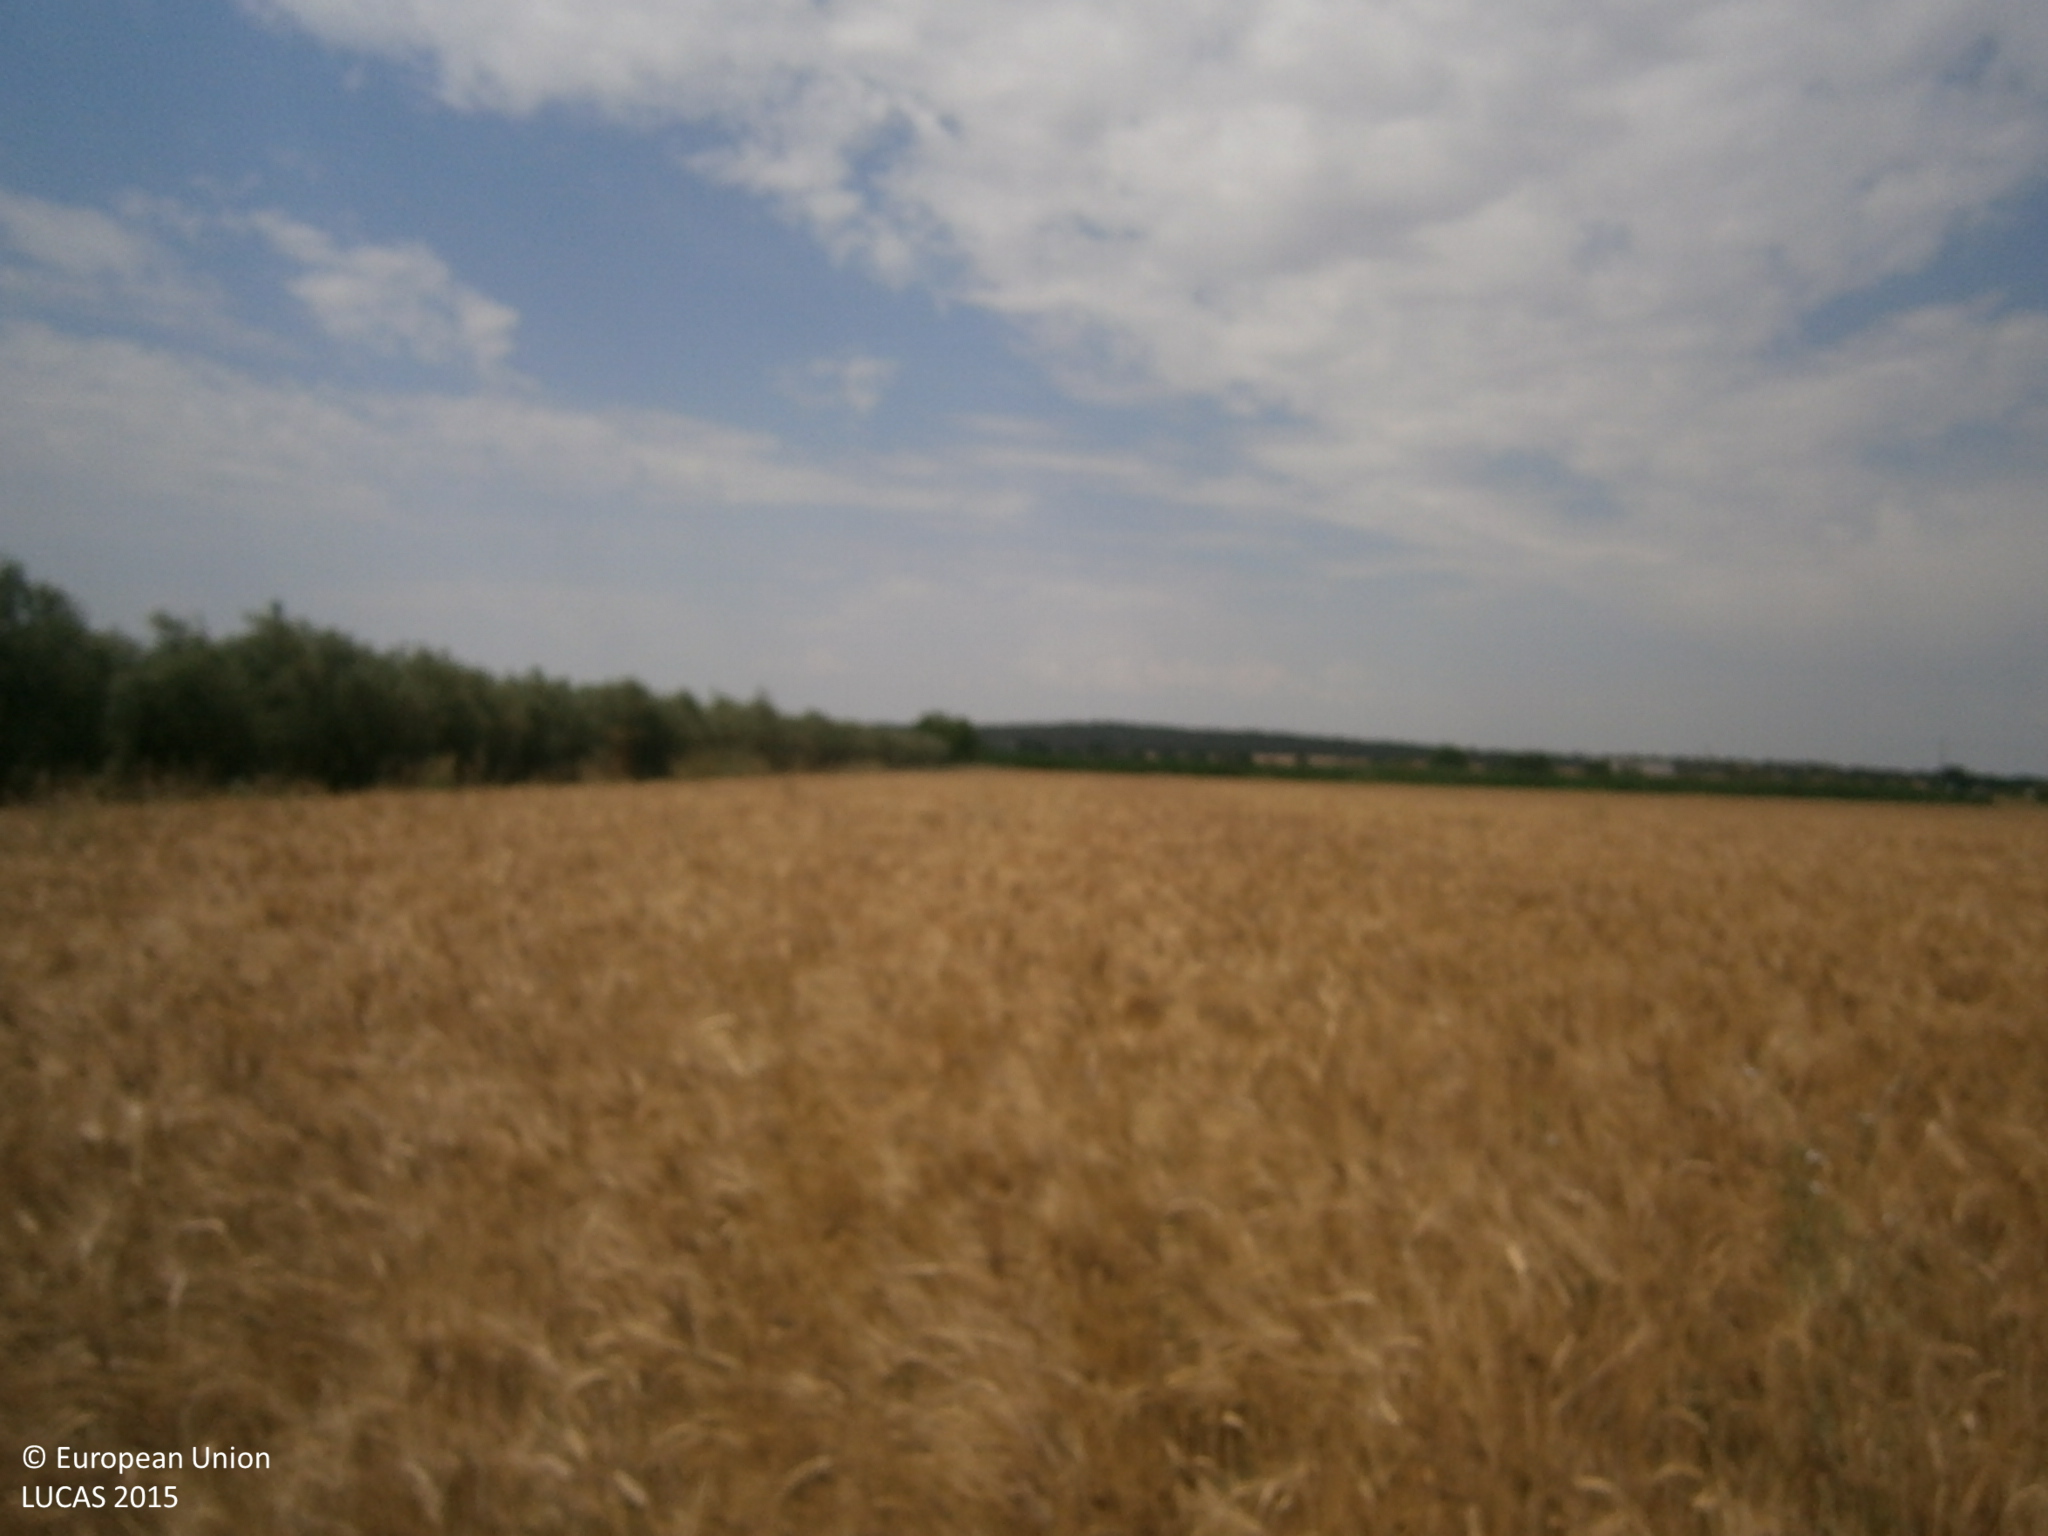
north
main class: Cropland
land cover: Durum wheat
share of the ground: > 75 %
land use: Agriculture (excluding fallow land and kitchen gardens)
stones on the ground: < 10 %
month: June
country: ES
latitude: 38.9077
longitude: -6.5403
